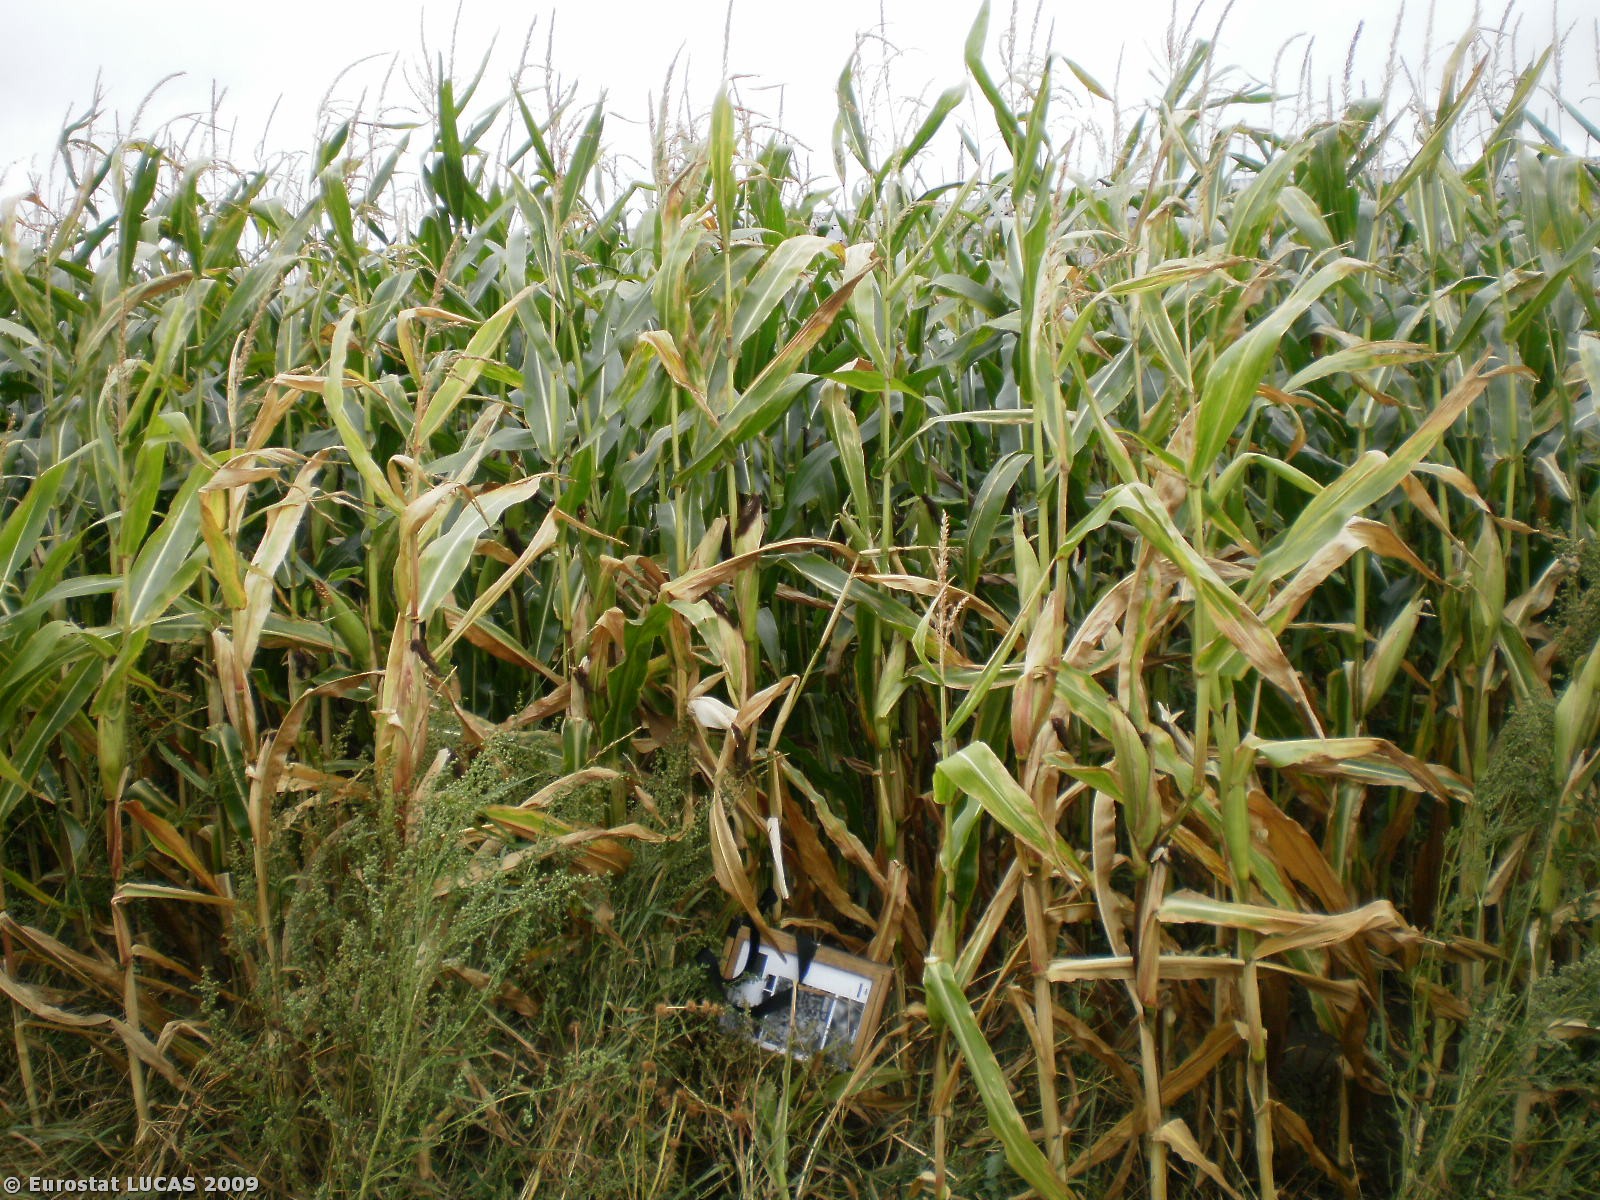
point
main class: Cropland
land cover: Maize
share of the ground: > 75 %
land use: Agriculture (excluding fallow land and kitchen gardens)
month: September
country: PL
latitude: 53.8756
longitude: 17.7548
